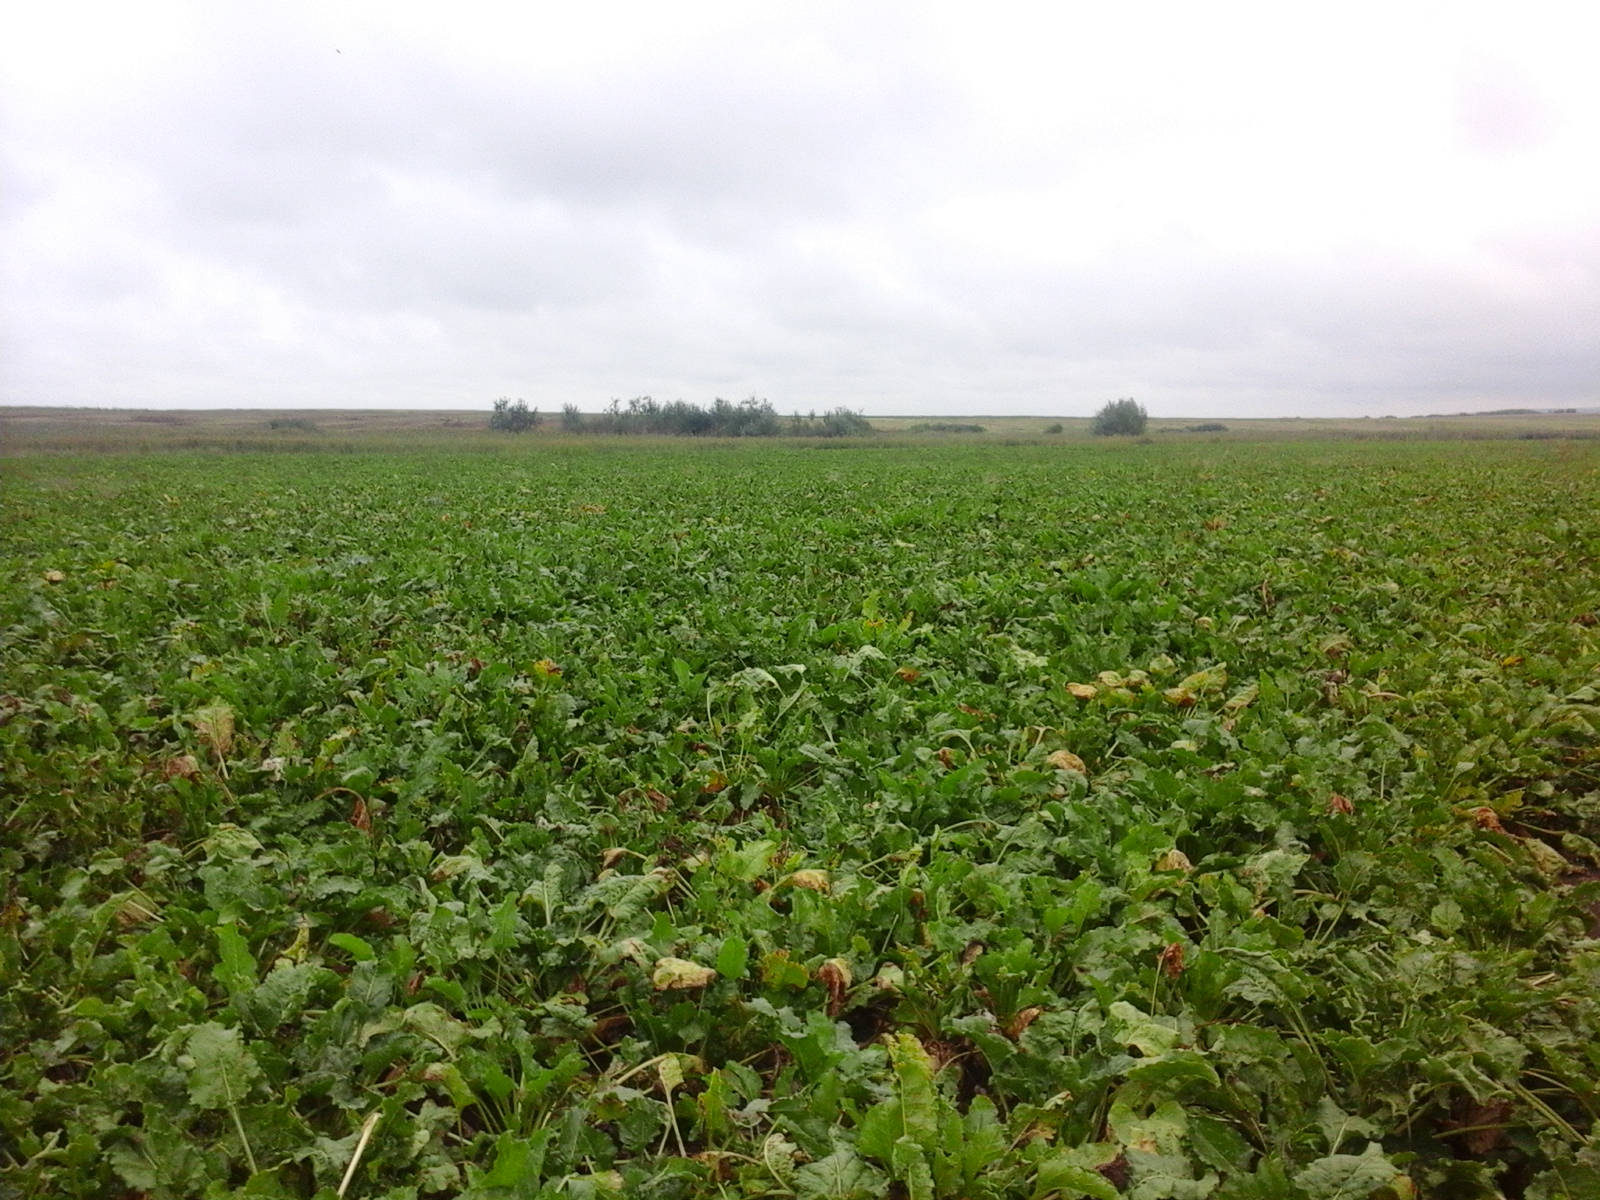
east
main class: Cropland
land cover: Sugar beet
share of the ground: > 75 %
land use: Agriculture (excluding fallow land and kitchen gardens)
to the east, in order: Sugar beet
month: September
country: RO
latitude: 47.1604
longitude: 21.8781
